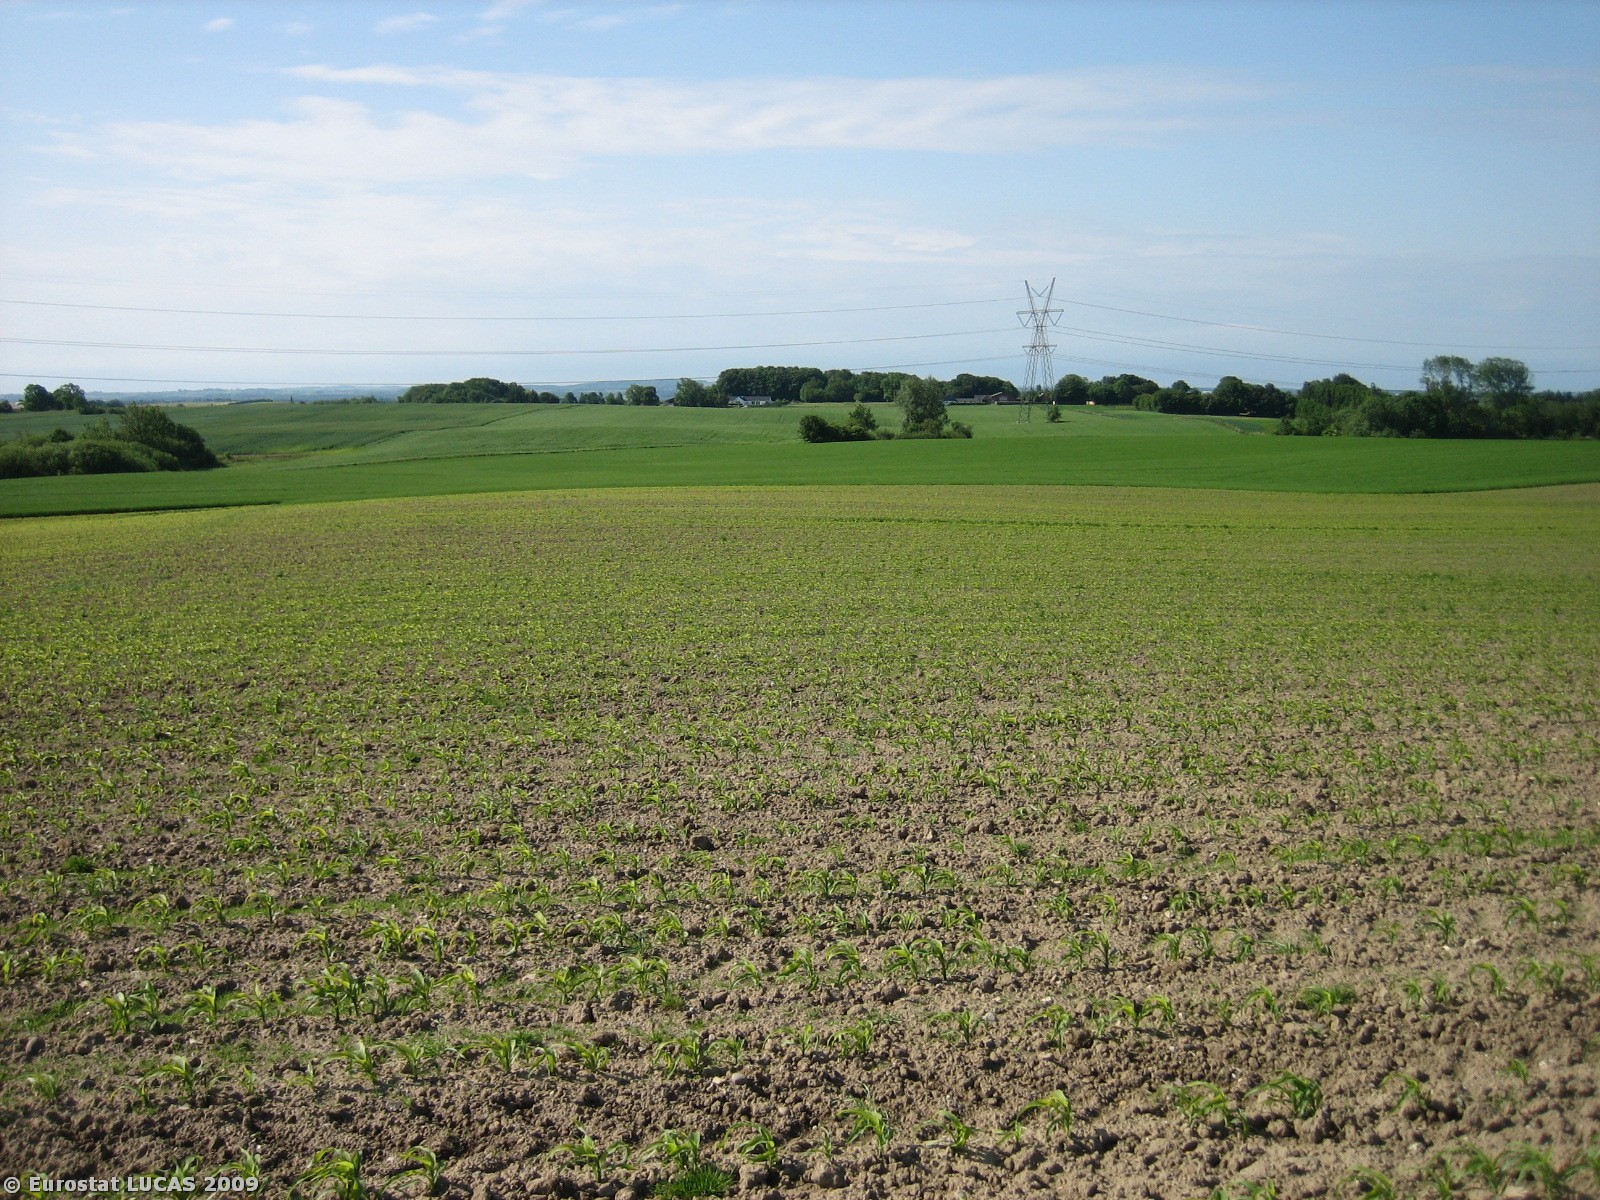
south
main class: Cropland
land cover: Maize
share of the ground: < 10 %
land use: Agriculture (excluding fallow land and kitchen gardens)
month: June
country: DK
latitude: 55.9181
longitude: 9.8881
